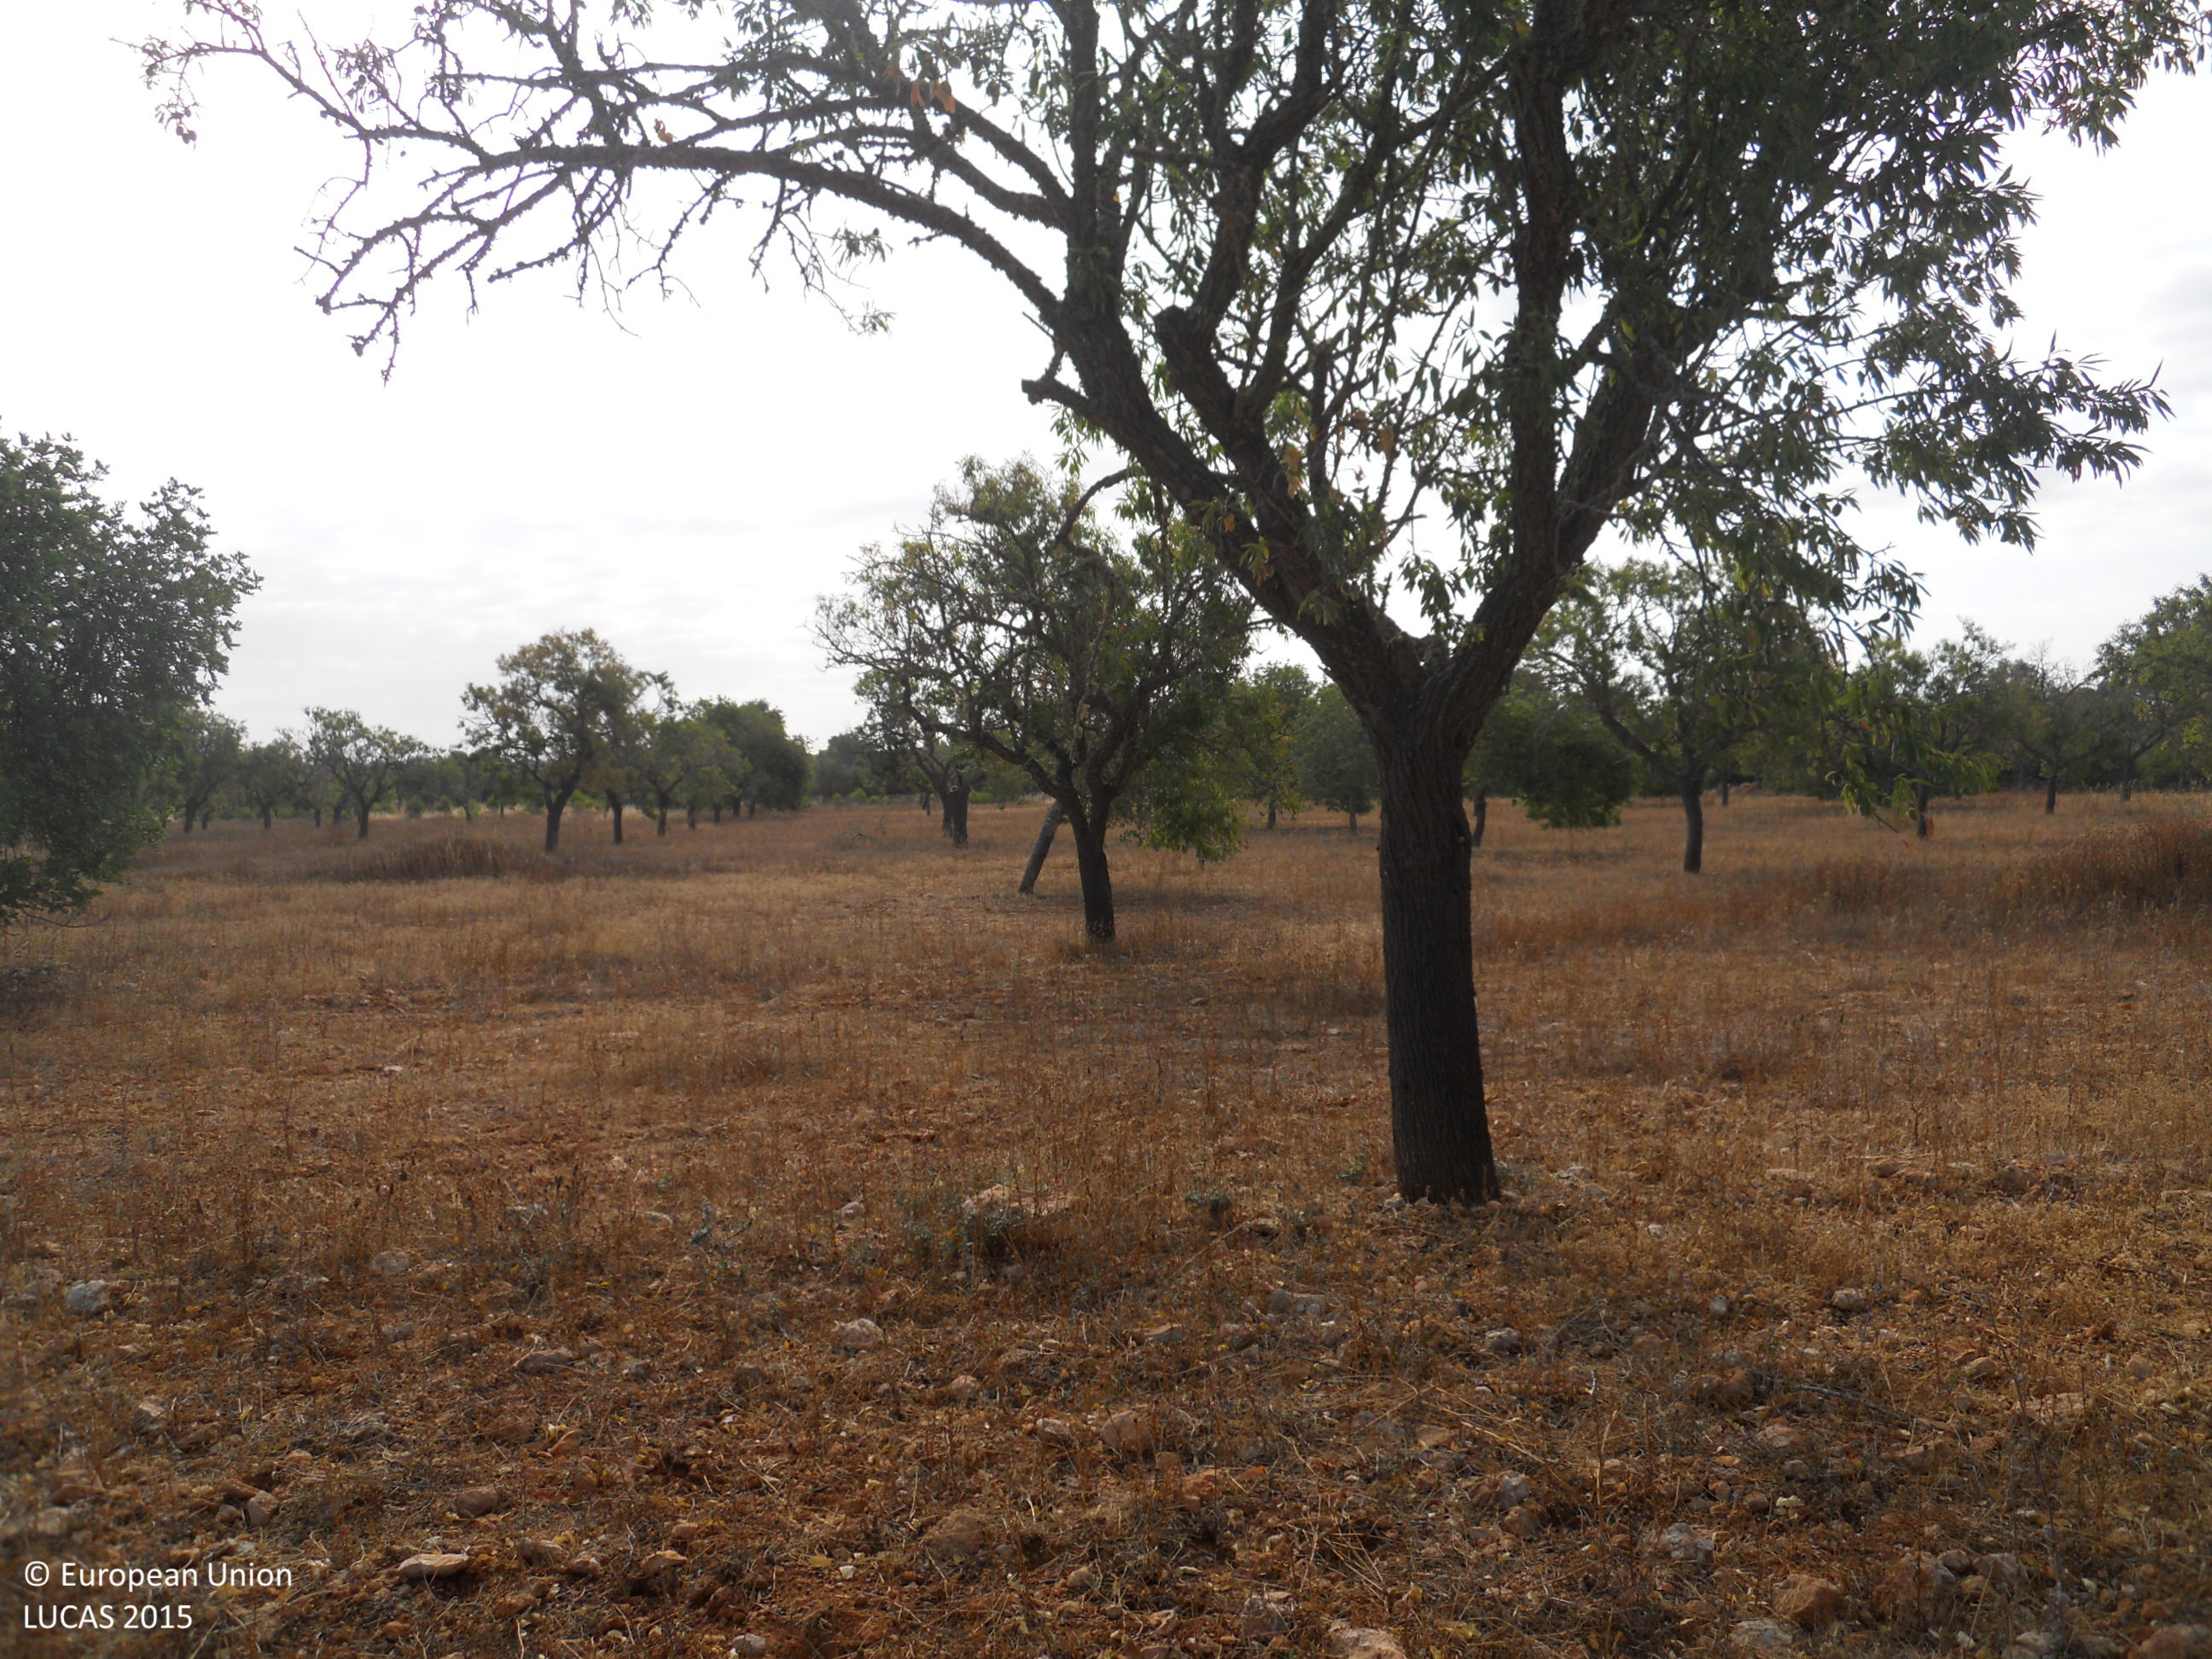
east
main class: Cropland
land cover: Nuts trees
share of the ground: 25 - 50 %
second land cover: Spontaneously vegetated surfaces
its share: 10 - 25 %
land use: Agriculture (excluding fallow land and kitchen gardens)
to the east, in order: Nuts trees; Spontaneously vegetated surfaces; Abandoned hedges; Dry stone walls; Tracks; Dry stone walls; Abandoned hedges; Nuts trees
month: July
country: ES
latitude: 39.3931
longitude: 2.9139
